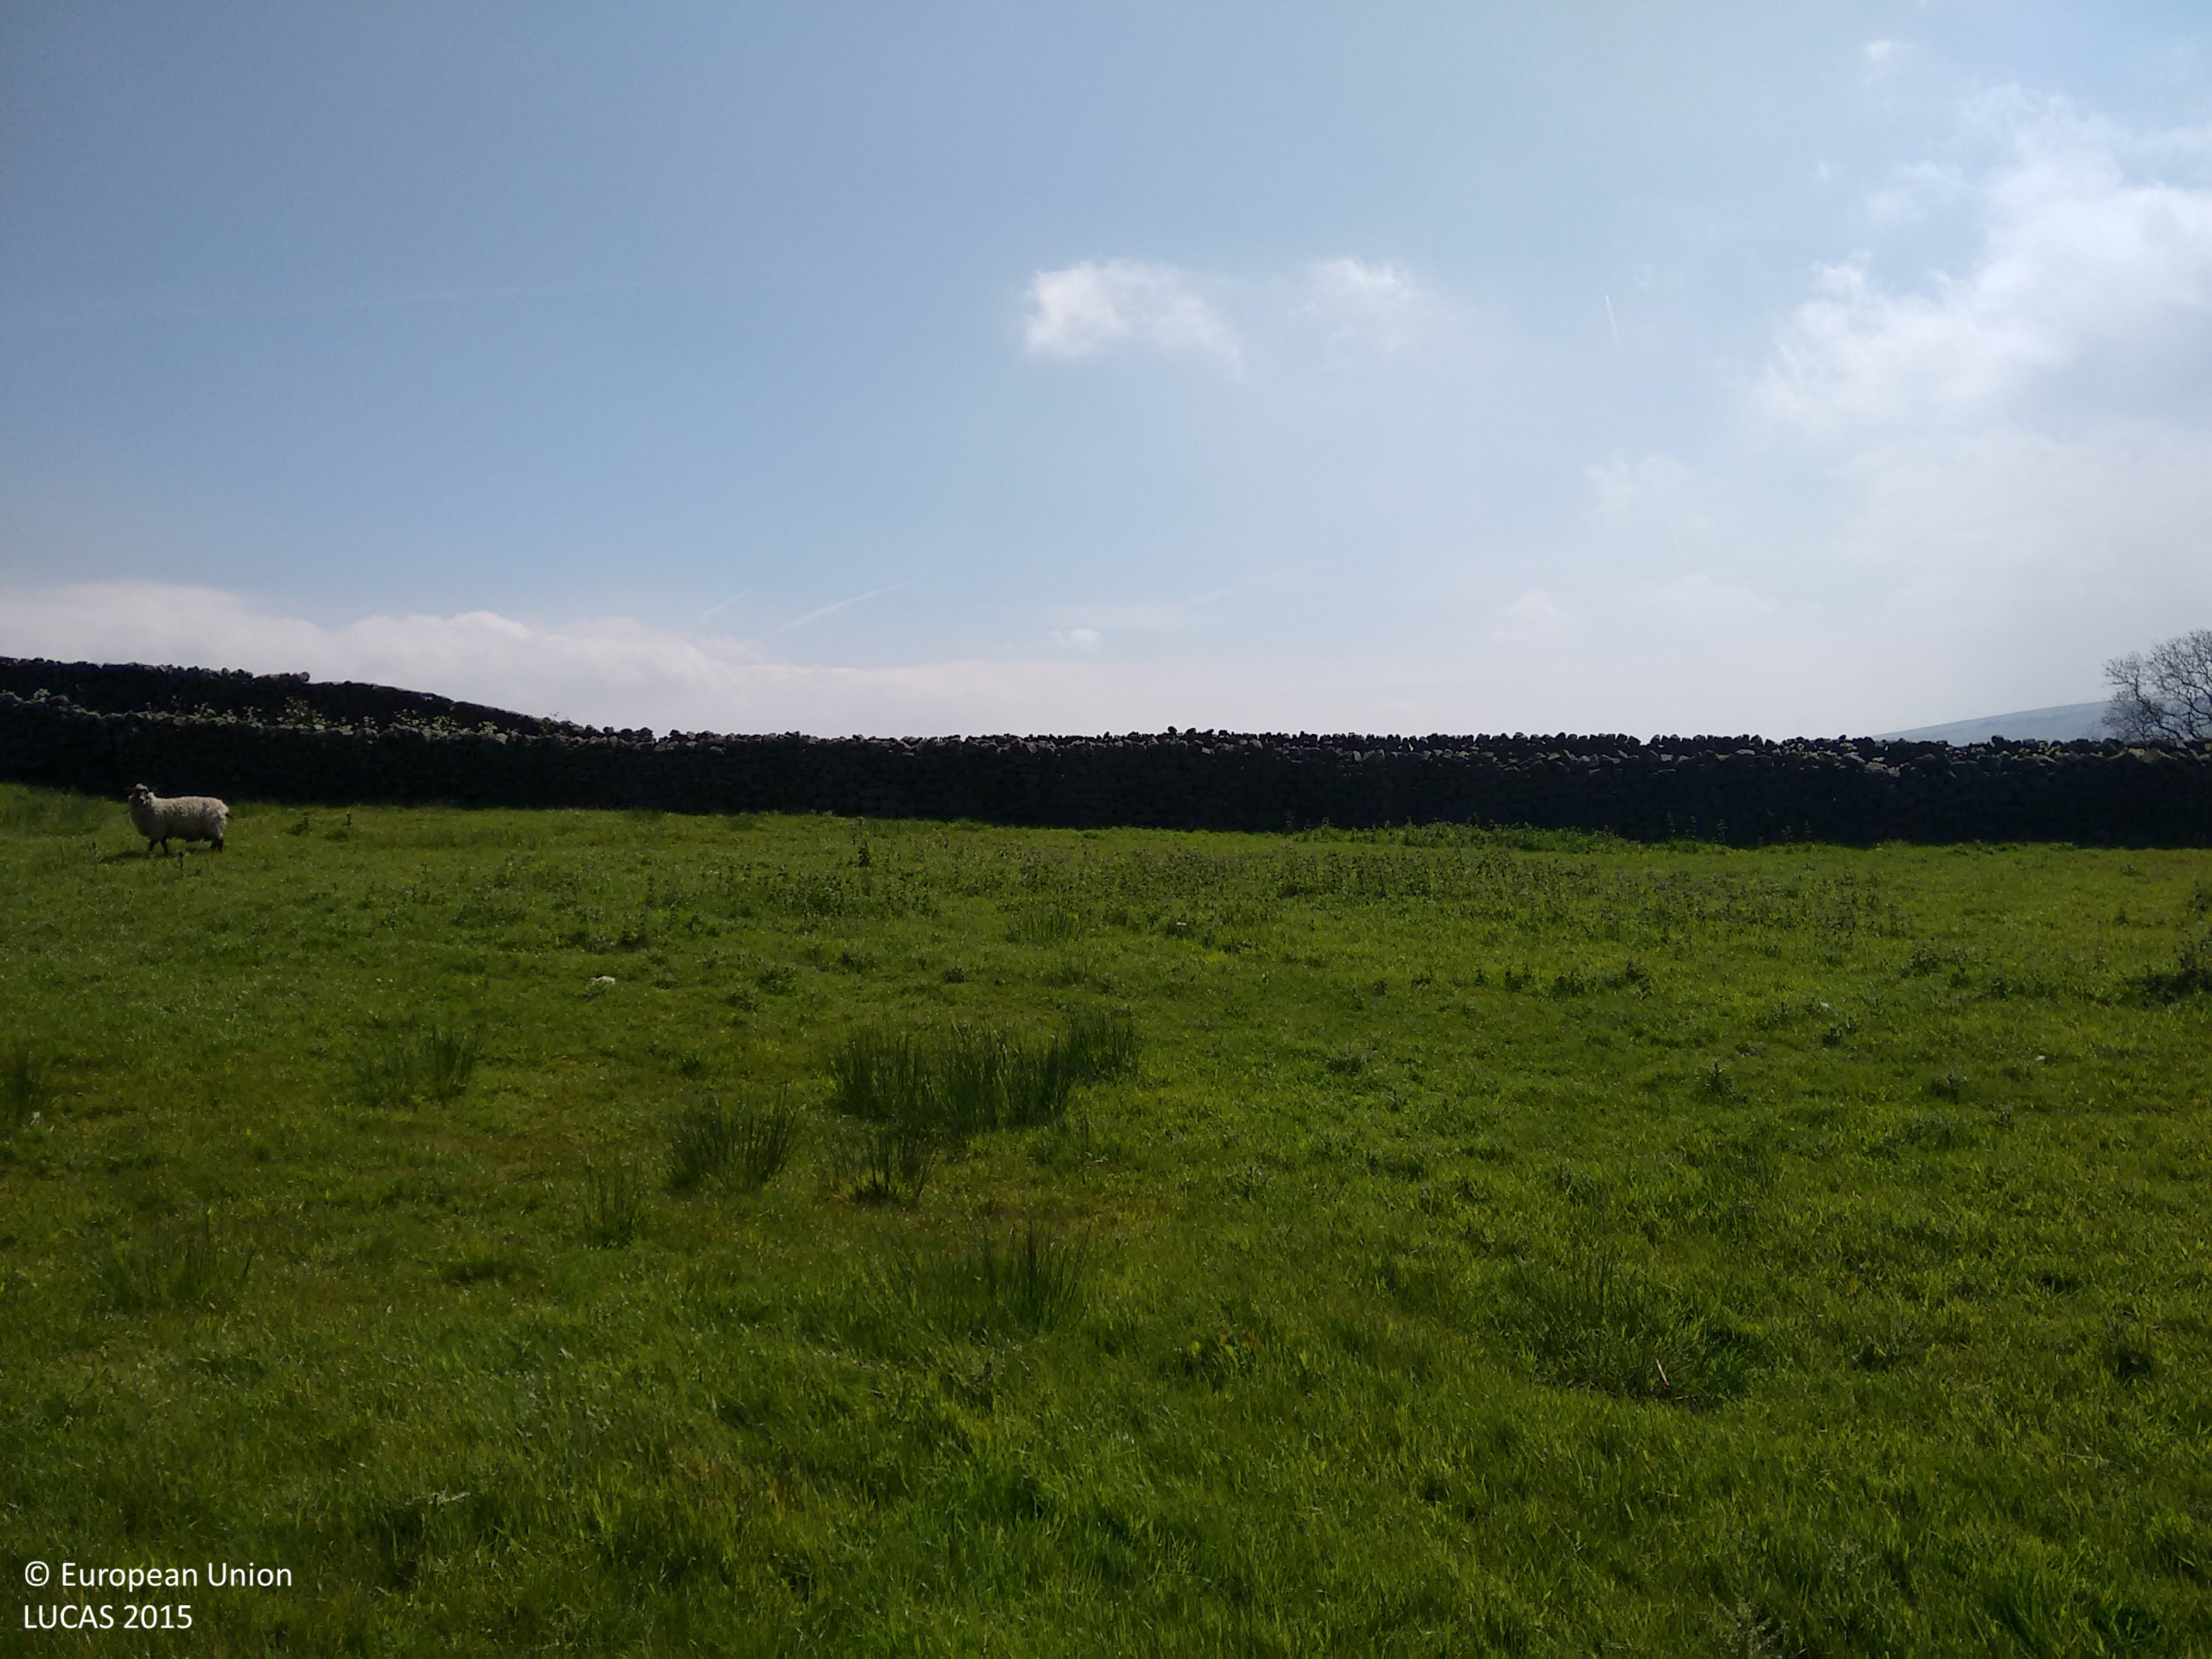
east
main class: Grassland
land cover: Grassland without tree/shrub cover
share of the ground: > 75 %
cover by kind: herbaceous plants 100 %
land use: Agriculture (excluding fallow land and kitchen gardens)
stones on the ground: < 10 %
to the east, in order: Grassland without tree/shrub cover; Dry stone walls; Grass margins; Paved roads, cycling and walking lanes; Grass margins; Dry stone walls; Grassland without tree/shrub cover; Dry stone walls; Grassland without tree/shrub cover; Electric lines; Tracks; Grassland without tree/shrub cover
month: June
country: GB
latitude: 53.9880
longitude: -1.9675
